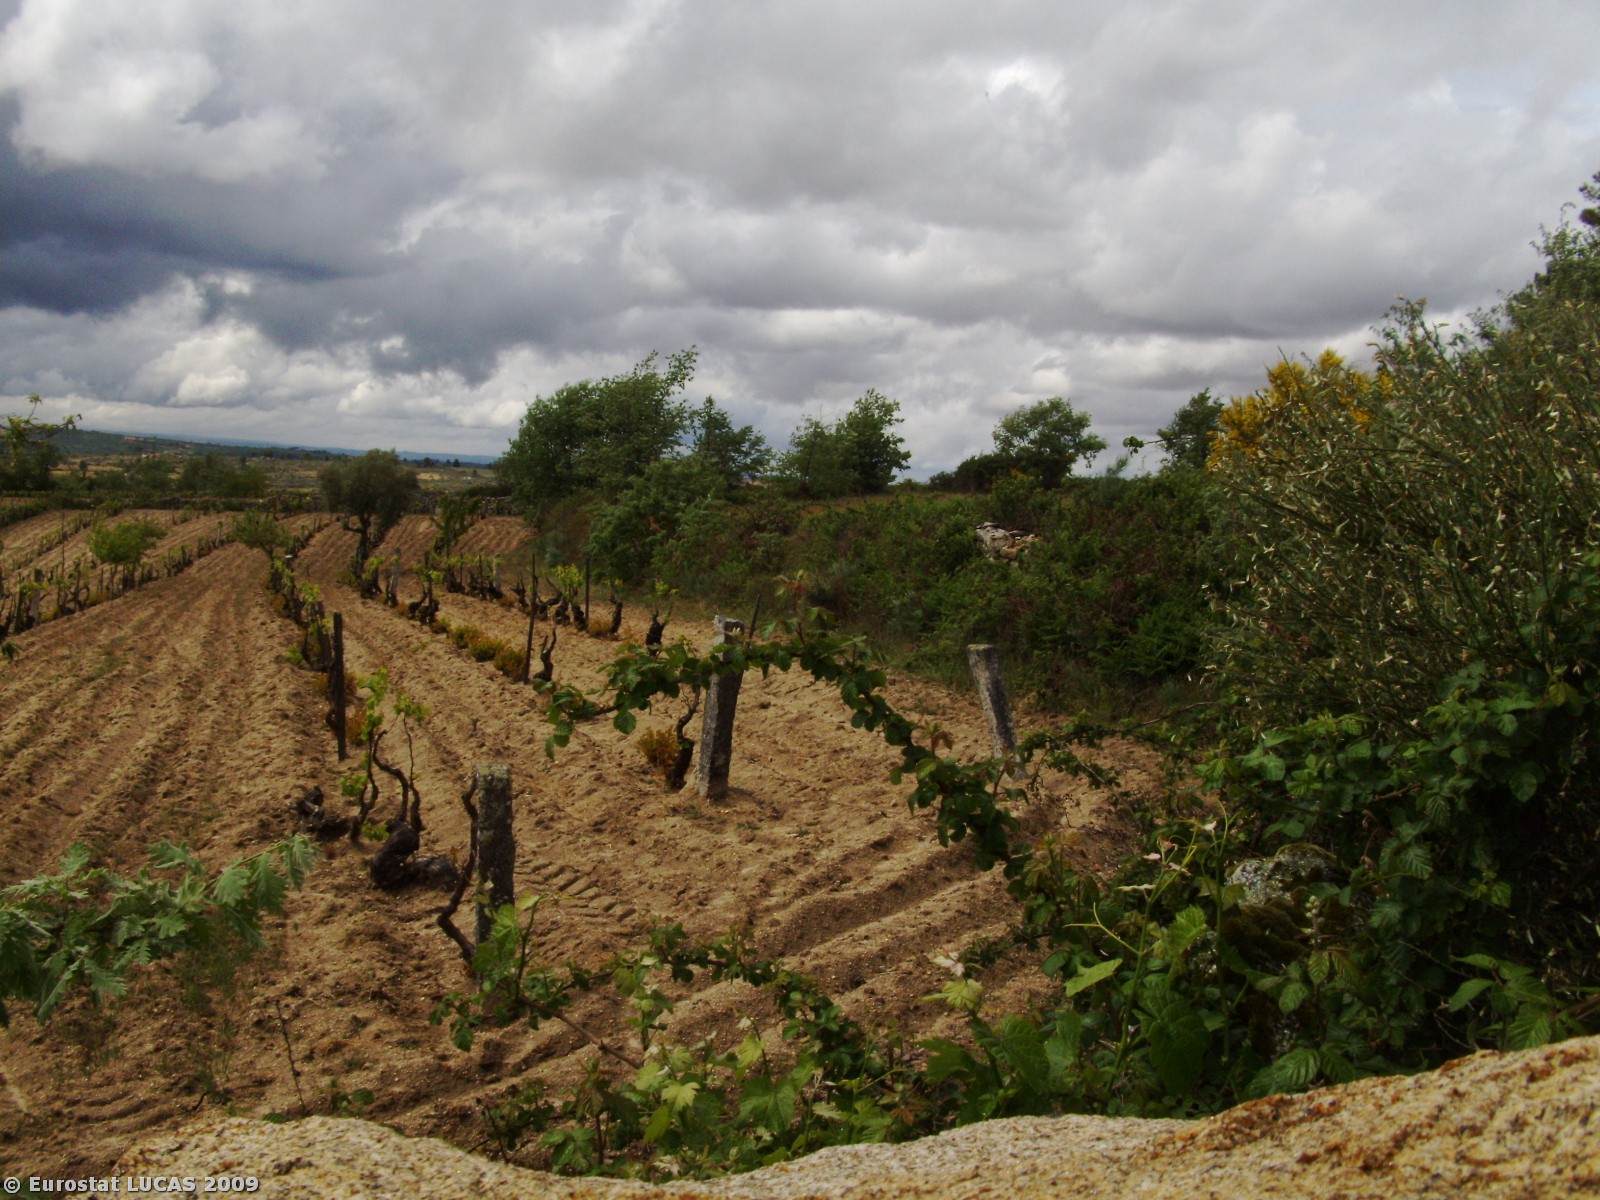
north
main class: Cropland
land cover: Vineyards
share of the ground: 10 - 25 %
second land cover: Bare land
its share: > 75 %
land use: Agriculture (excluding fallow land and kitchen gardens)
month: May
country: PT
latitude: 40.6746
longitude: -7.0803
